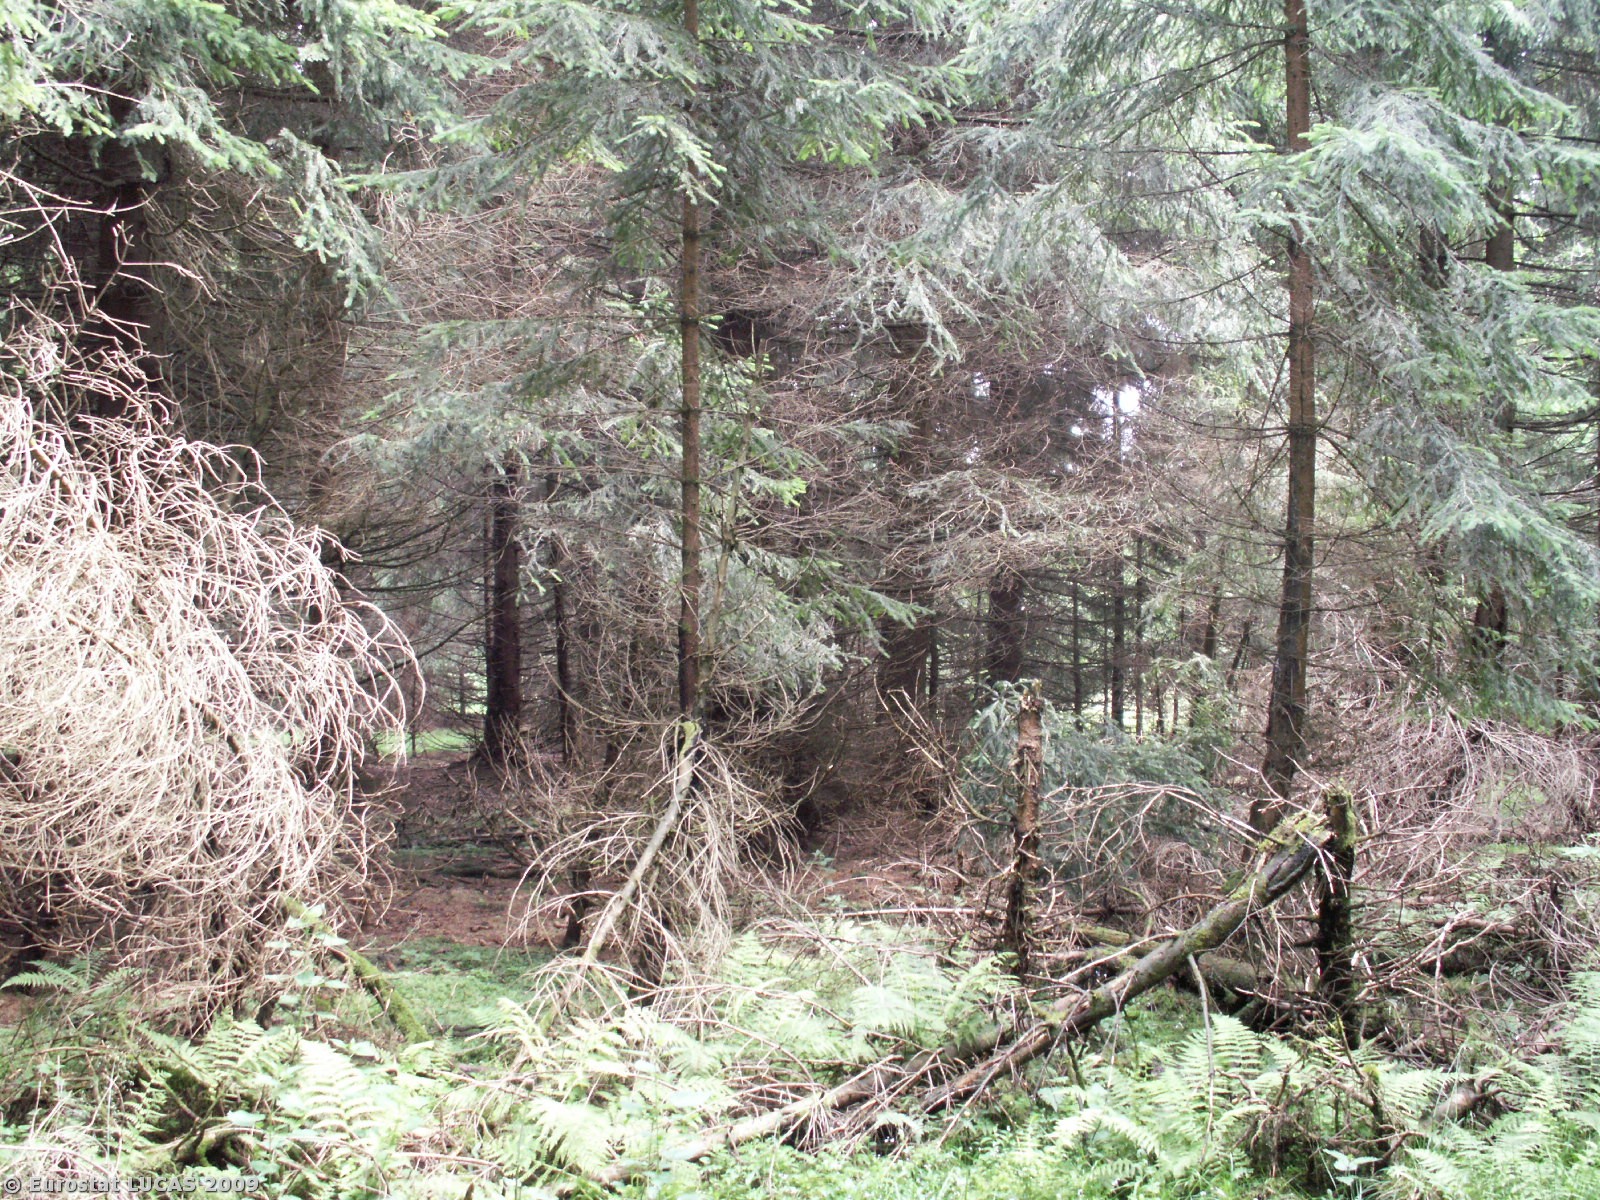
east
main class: Woodland
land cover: Coniferous woodland
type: hemiboreal forest and nemoral coniferous forest and mixed broadleaved-coniferous forest
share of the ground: > 75 %
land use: Forestry
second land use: Nature reserves
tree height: > 5 m
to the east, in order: Coniferous woodland; Grassland with sparse tree/shrub cover; Coniferous woodland; Grassland with sparse tree/shrub cover; Coniferous woodland
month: July
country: CZ
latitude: 50.0797
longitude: 12.7248
